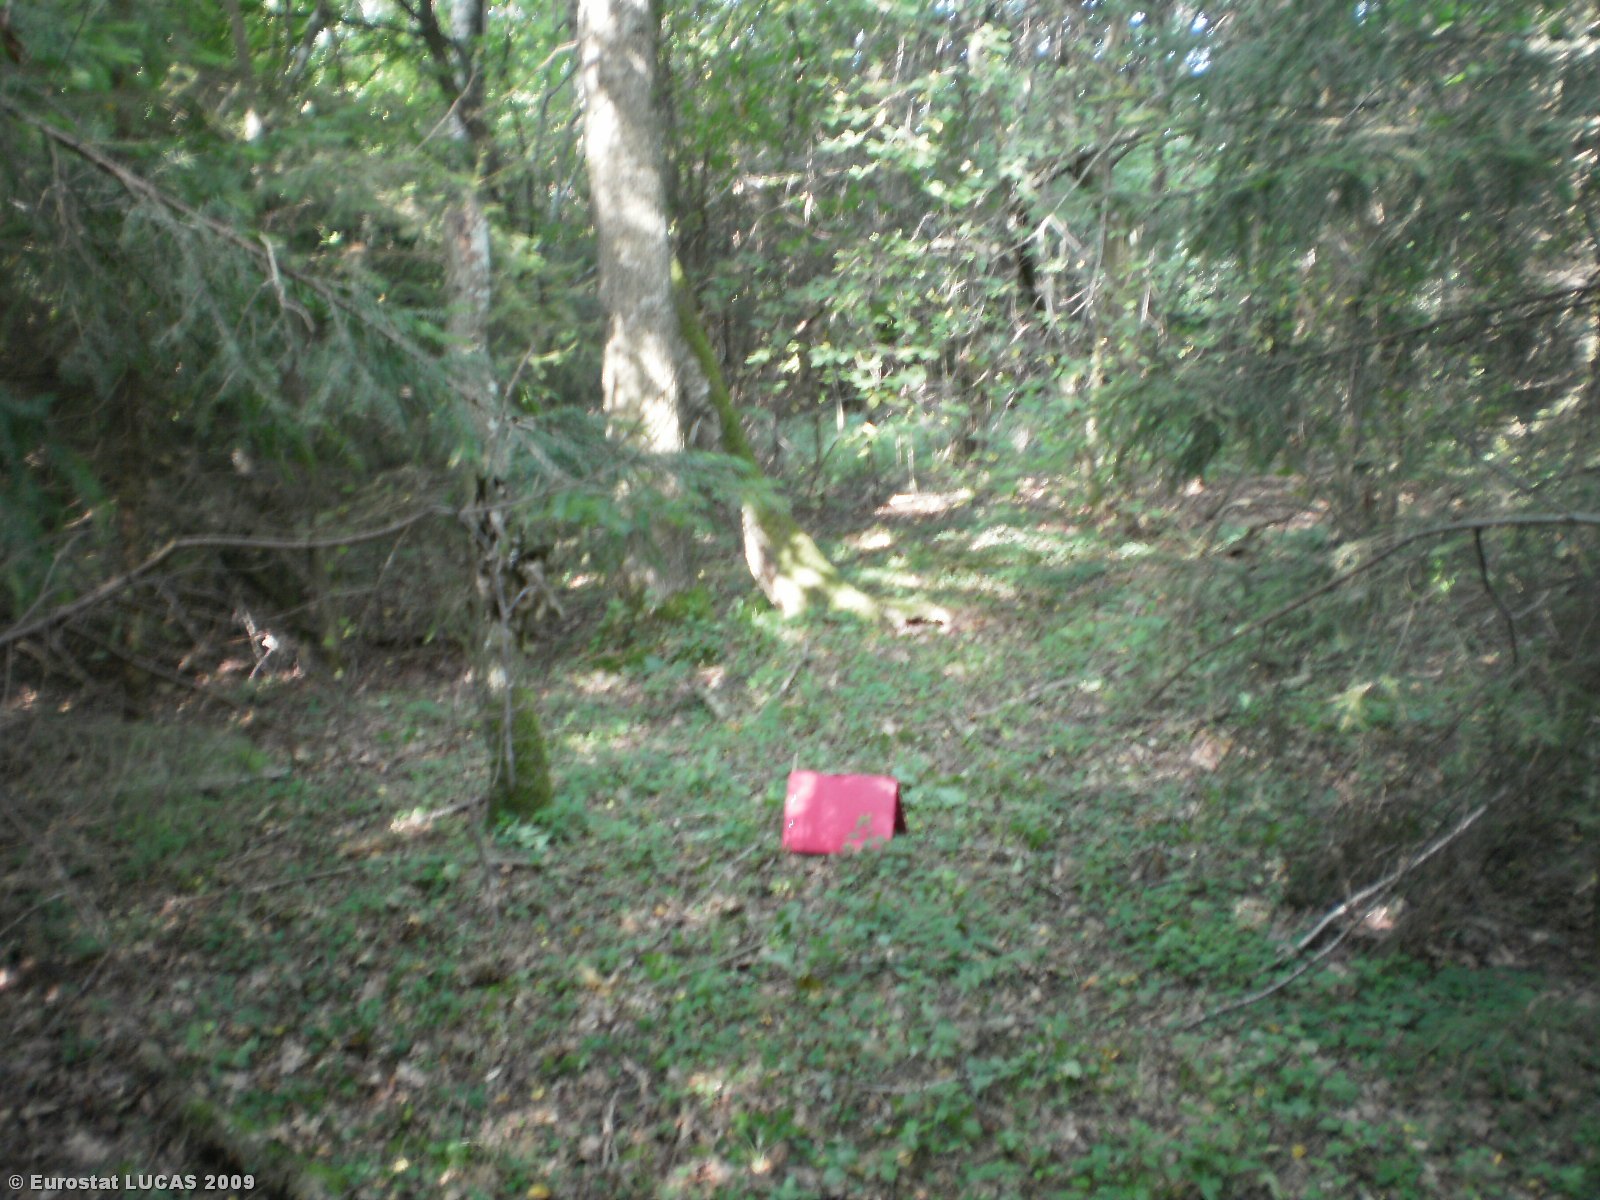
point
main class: Woodland
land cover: Mixed woodland
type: hemiboreal forest and nemoral coniferous forest and mixed broadleaved-coniferous forest
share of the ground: > 75 %
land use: Forestry
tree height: > 5 m
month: August
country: LT
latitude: 55.1174
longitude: 24.8315
